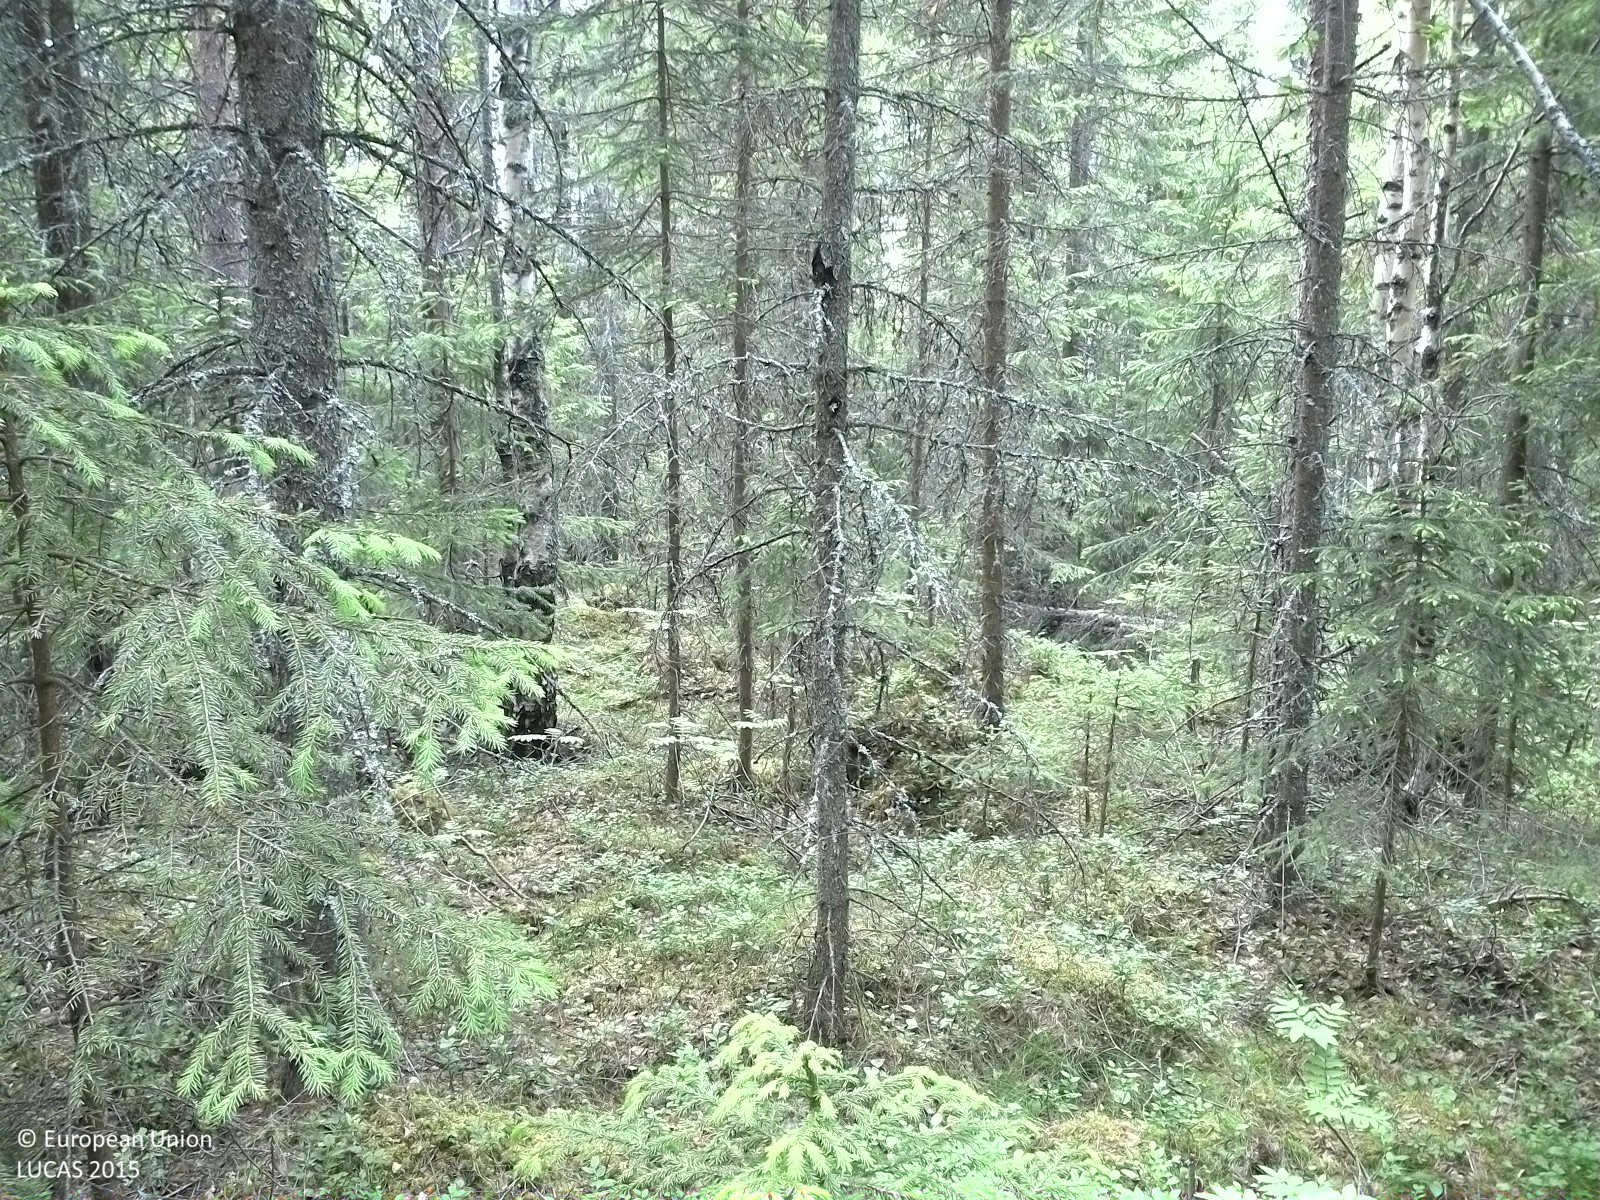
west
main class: Woodland
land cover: Spruce dominated mixed woodland
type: boreal forest
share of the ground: 50 - 75 %
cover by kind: coniferous forest trees 40 %, shrubs 30 %, broadleaved forest trees 25 %, herbaceous plants 5 %
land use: Forestry
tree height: > 5 m
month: July
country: SE
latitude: 62.1801
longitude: 16.9534
